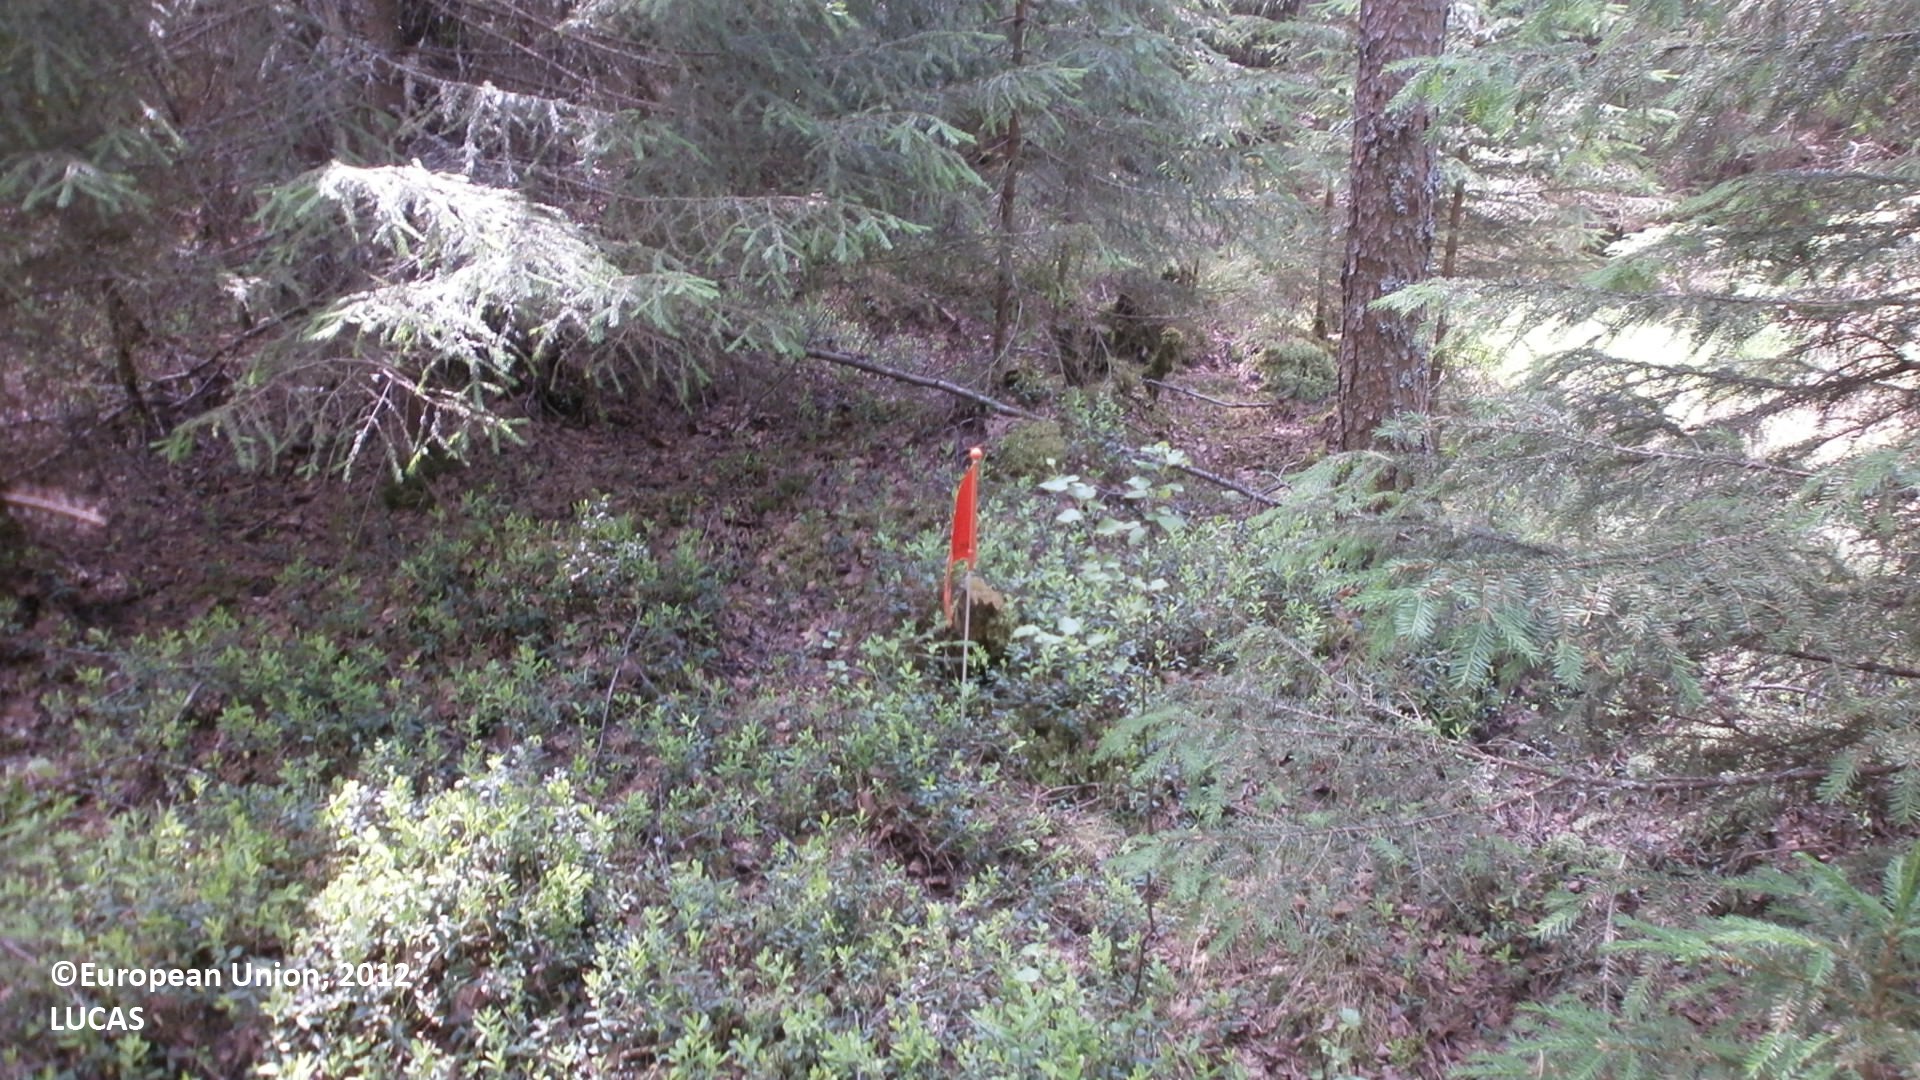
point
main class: Woodland
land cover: Pine dominated mixed woodland
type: boreal forest
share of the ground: > 75 %
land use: Forestry
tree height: > 5 m
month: July
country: FI
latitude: 64.0876
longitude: 24.7850
